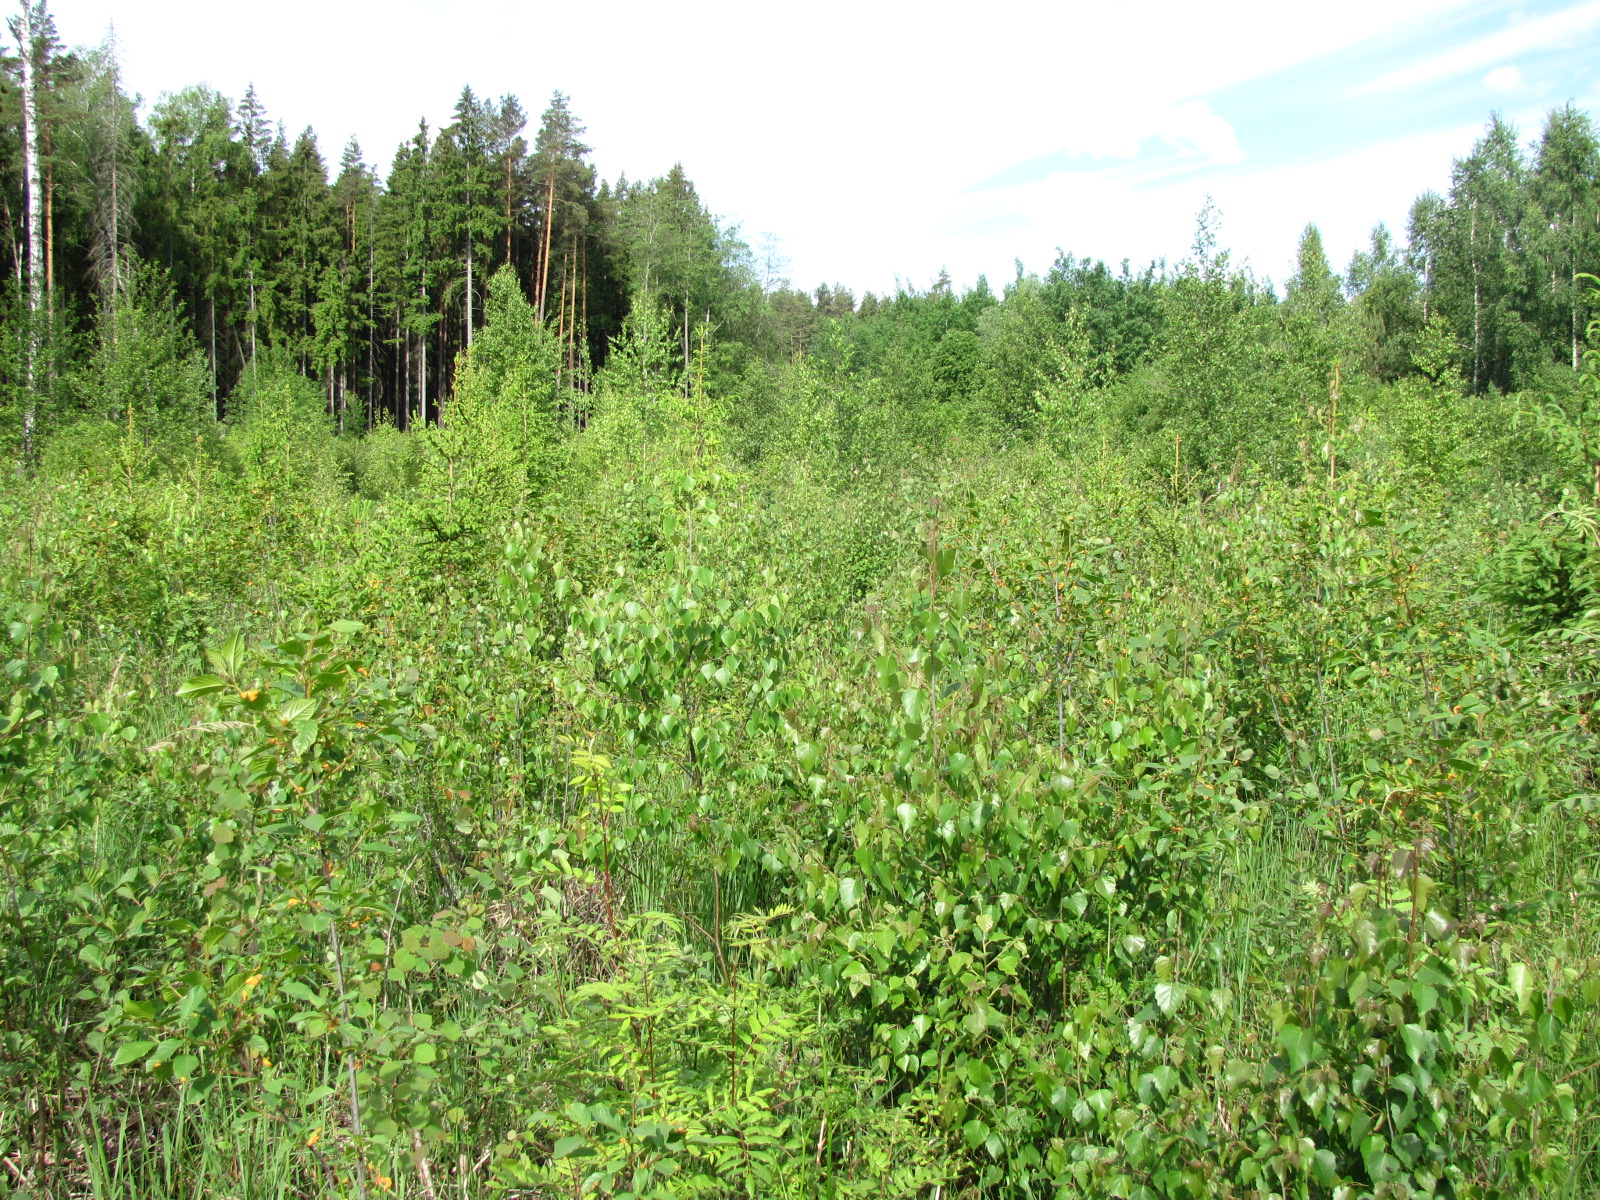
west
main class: Woodland
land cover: Spruce dominated mixed woodland
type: hemiboreal forest and nemoral coniferous forest and mixed broadleaved-coniferous forest
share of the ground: 50 - 75 %
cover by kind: broadleaved forest trees 40 %, coniferous forest trees 30 %, herbaceous plants 30 %
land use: Forestry
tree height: < 5 m
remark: Nursery
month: June
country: LV
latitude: 56.7005
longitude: 23.9487
